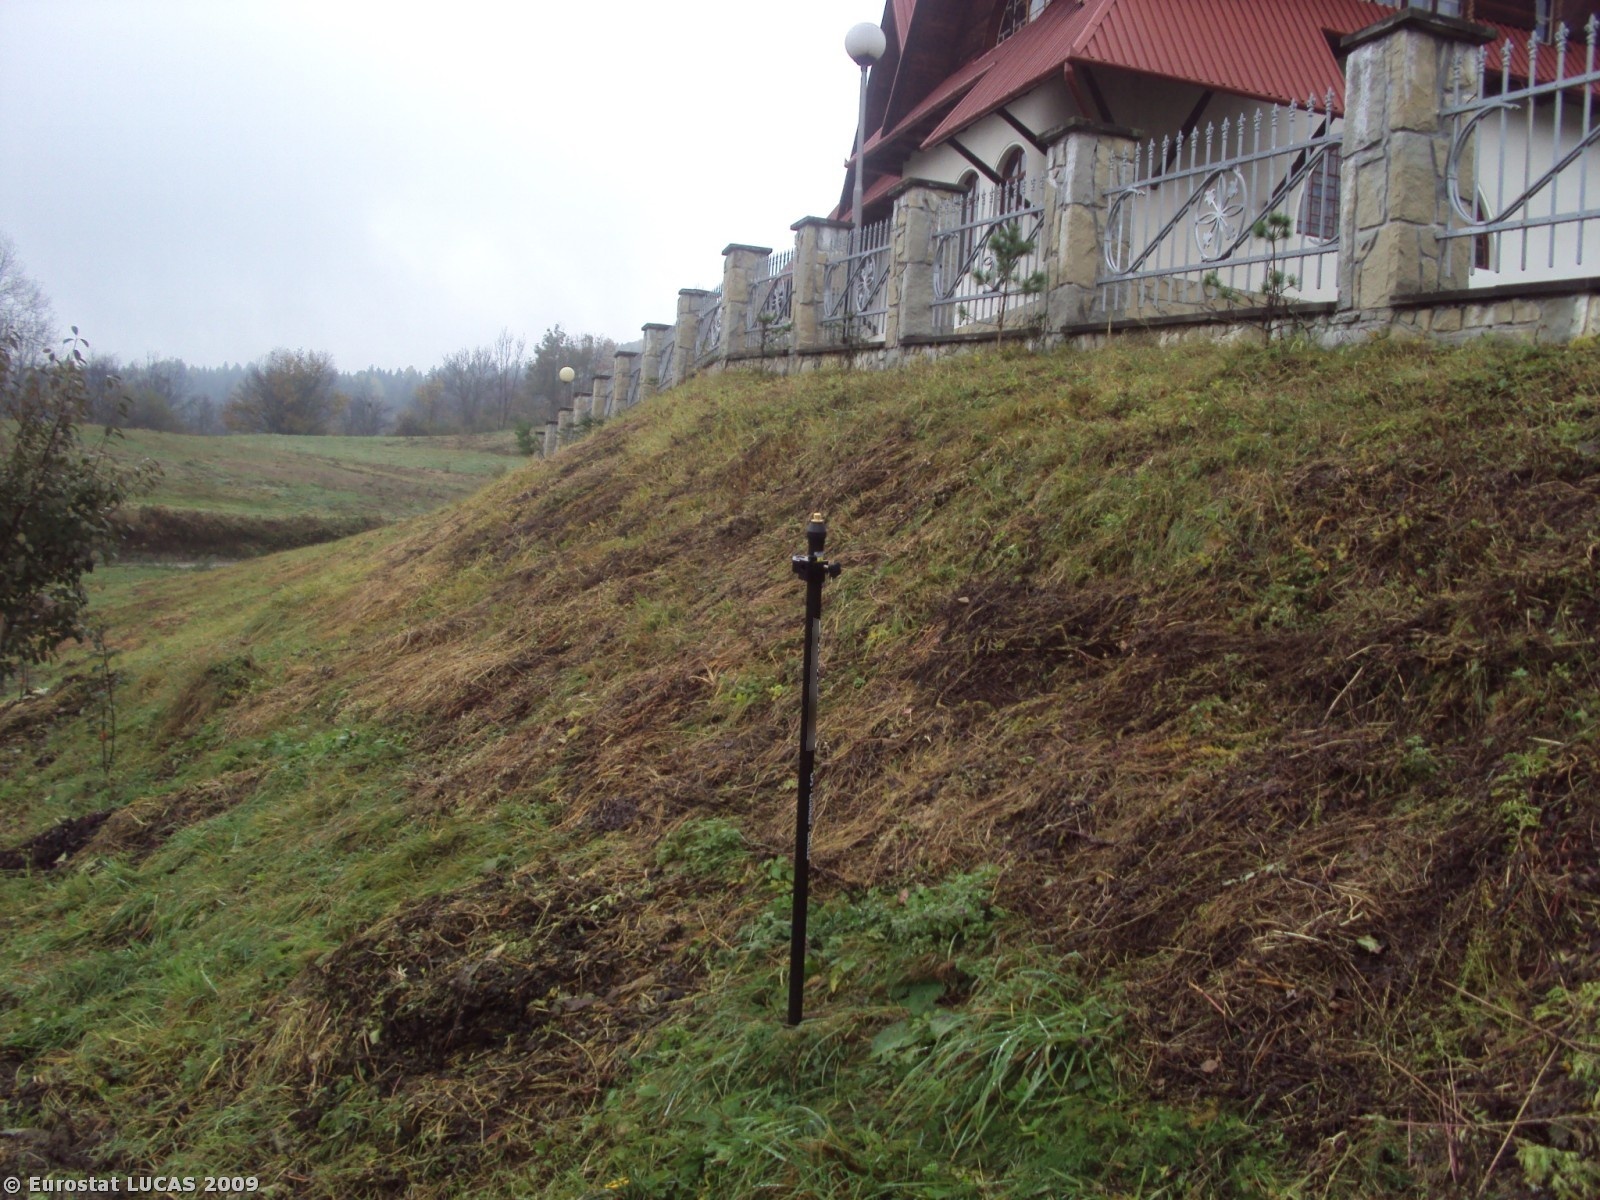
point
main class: Grassland
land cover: Grassland without tree/shrub cover
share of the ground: > 75 %
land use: Agriculture (excluding fallow land and kitchen gardens)
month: September
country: PL
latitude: 49.6770
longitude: 20.1358
